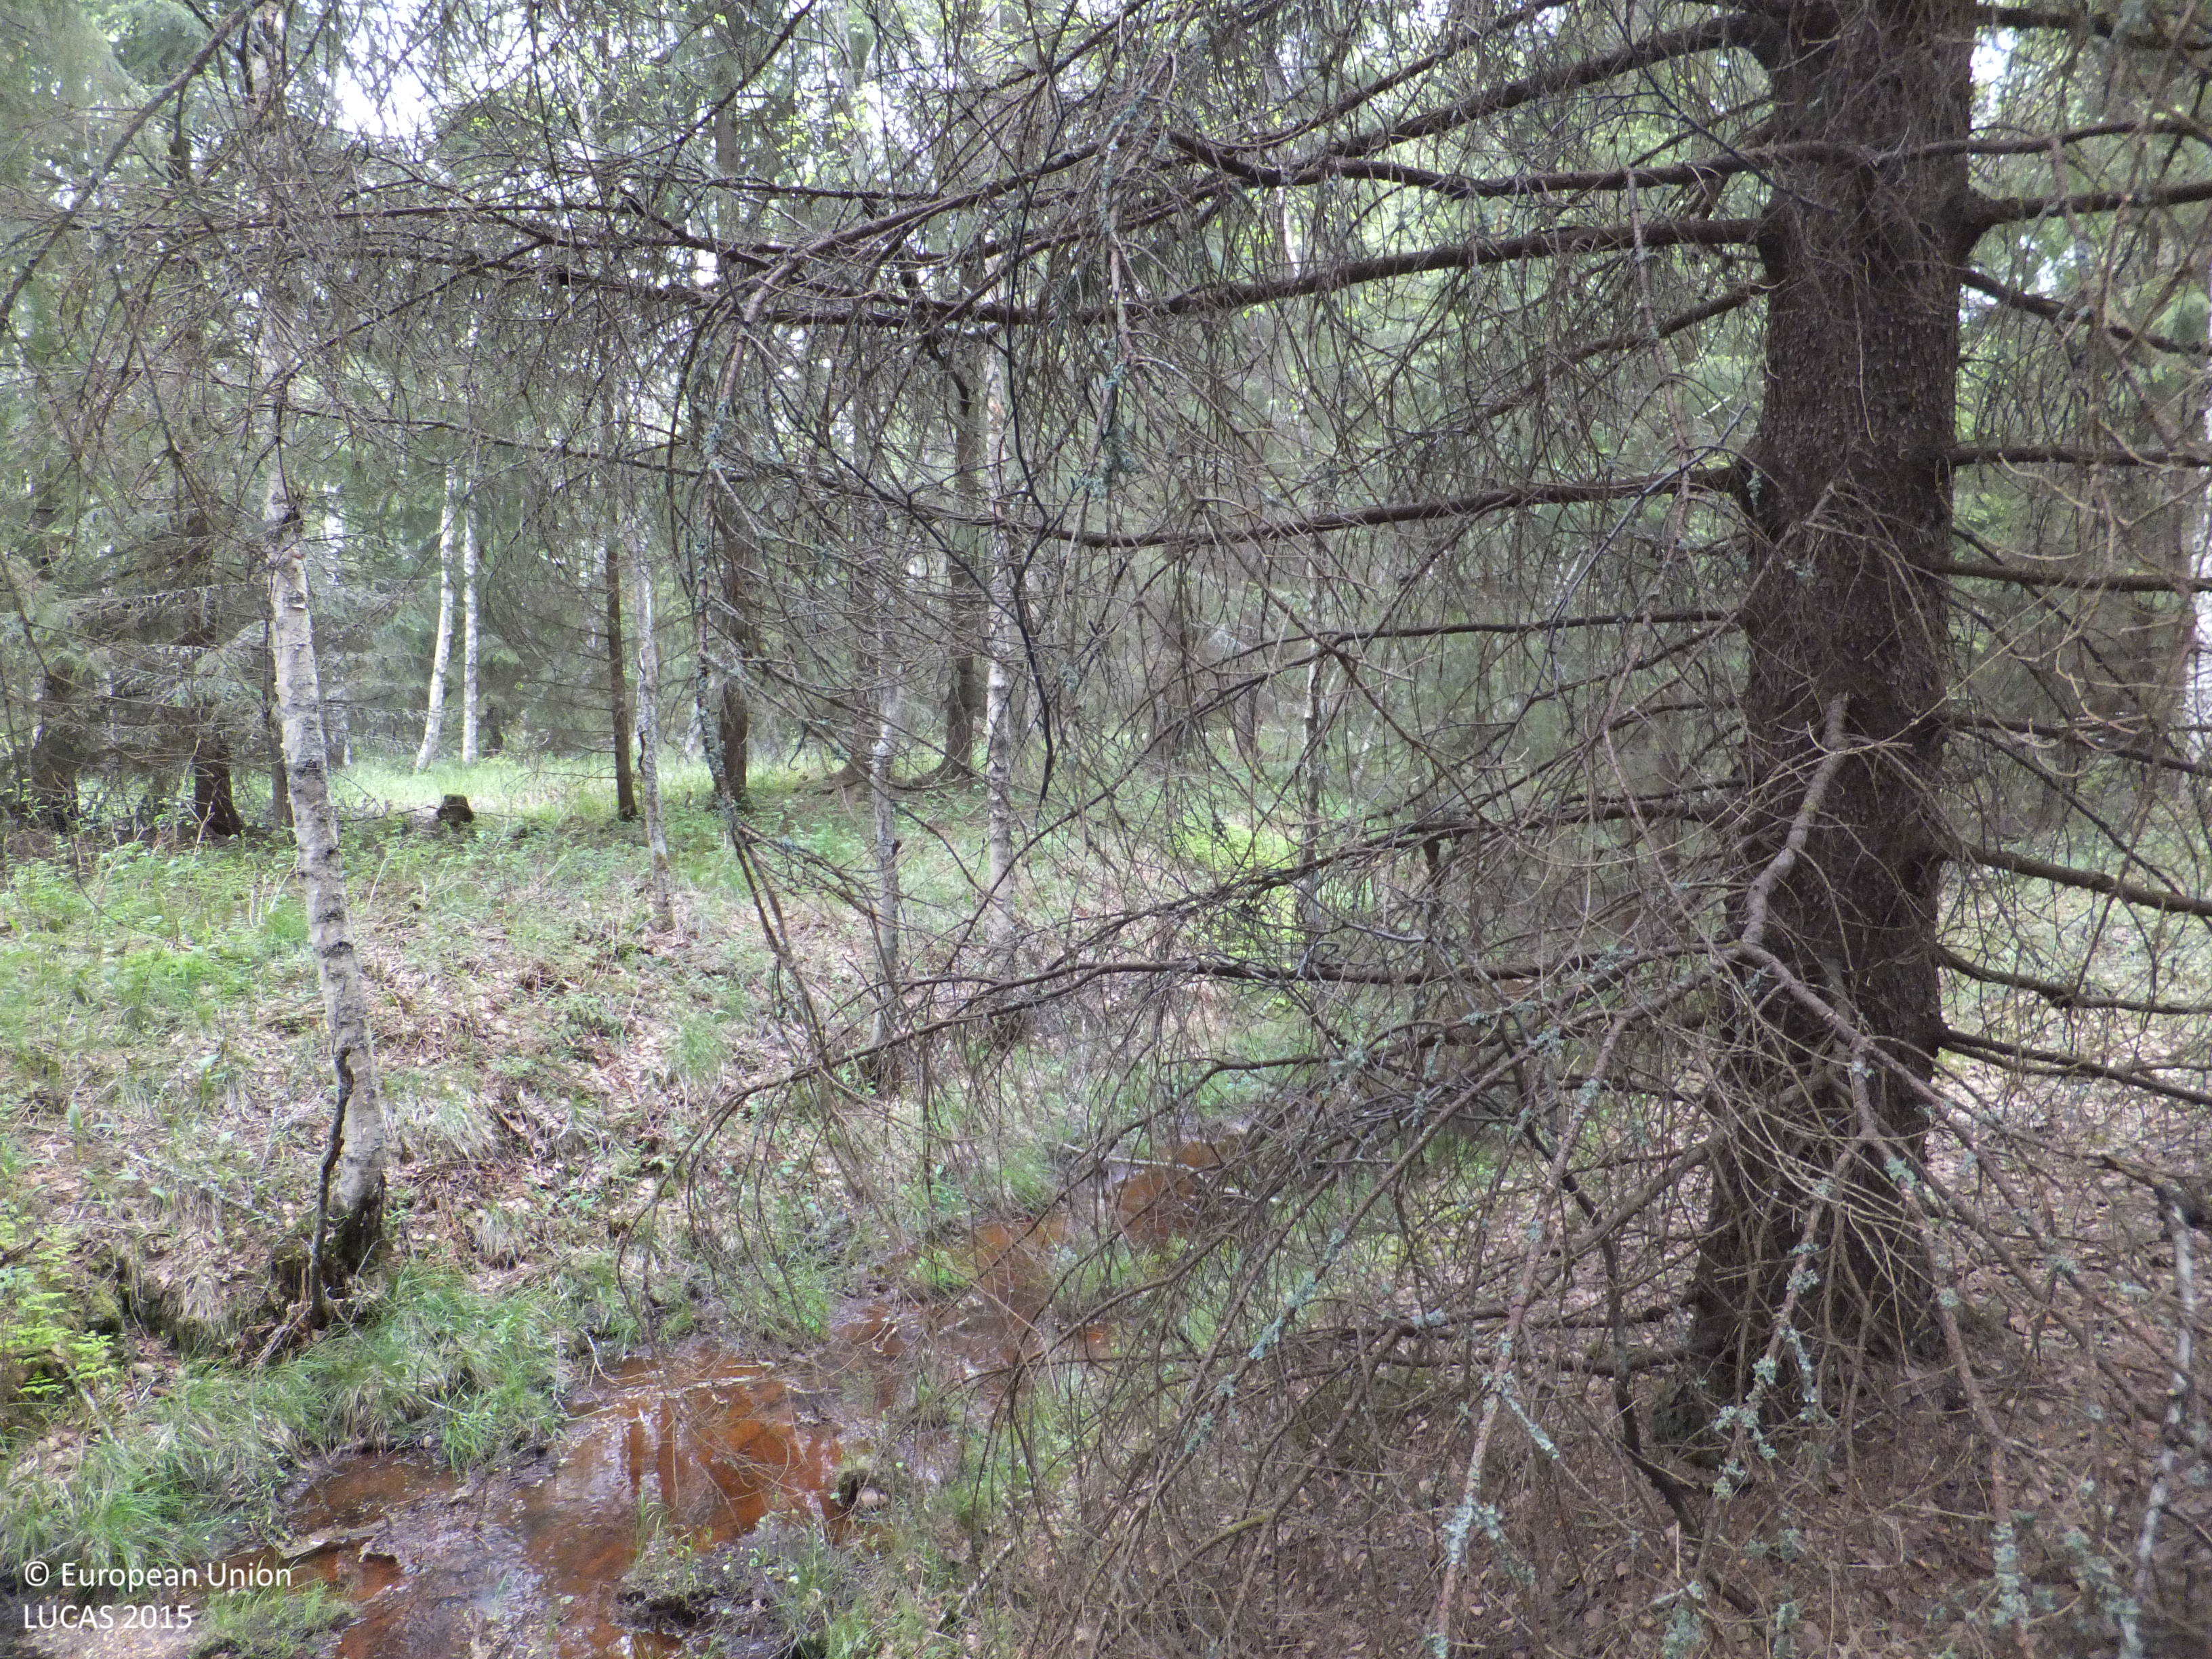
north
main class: Woodland
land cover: Spruce dominated mixed woodland
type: boreal forest
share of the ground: 50 - 75 %
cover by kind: coniferous forest trees 40 %, broadleaved forest trees 30 %, shrubs 10 %, herbaceous plants 10 %, lichens and mosses 10 %
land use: Forestry
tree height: > 5 m
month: June
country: FI
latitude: 63.4776
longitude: 22.7566
